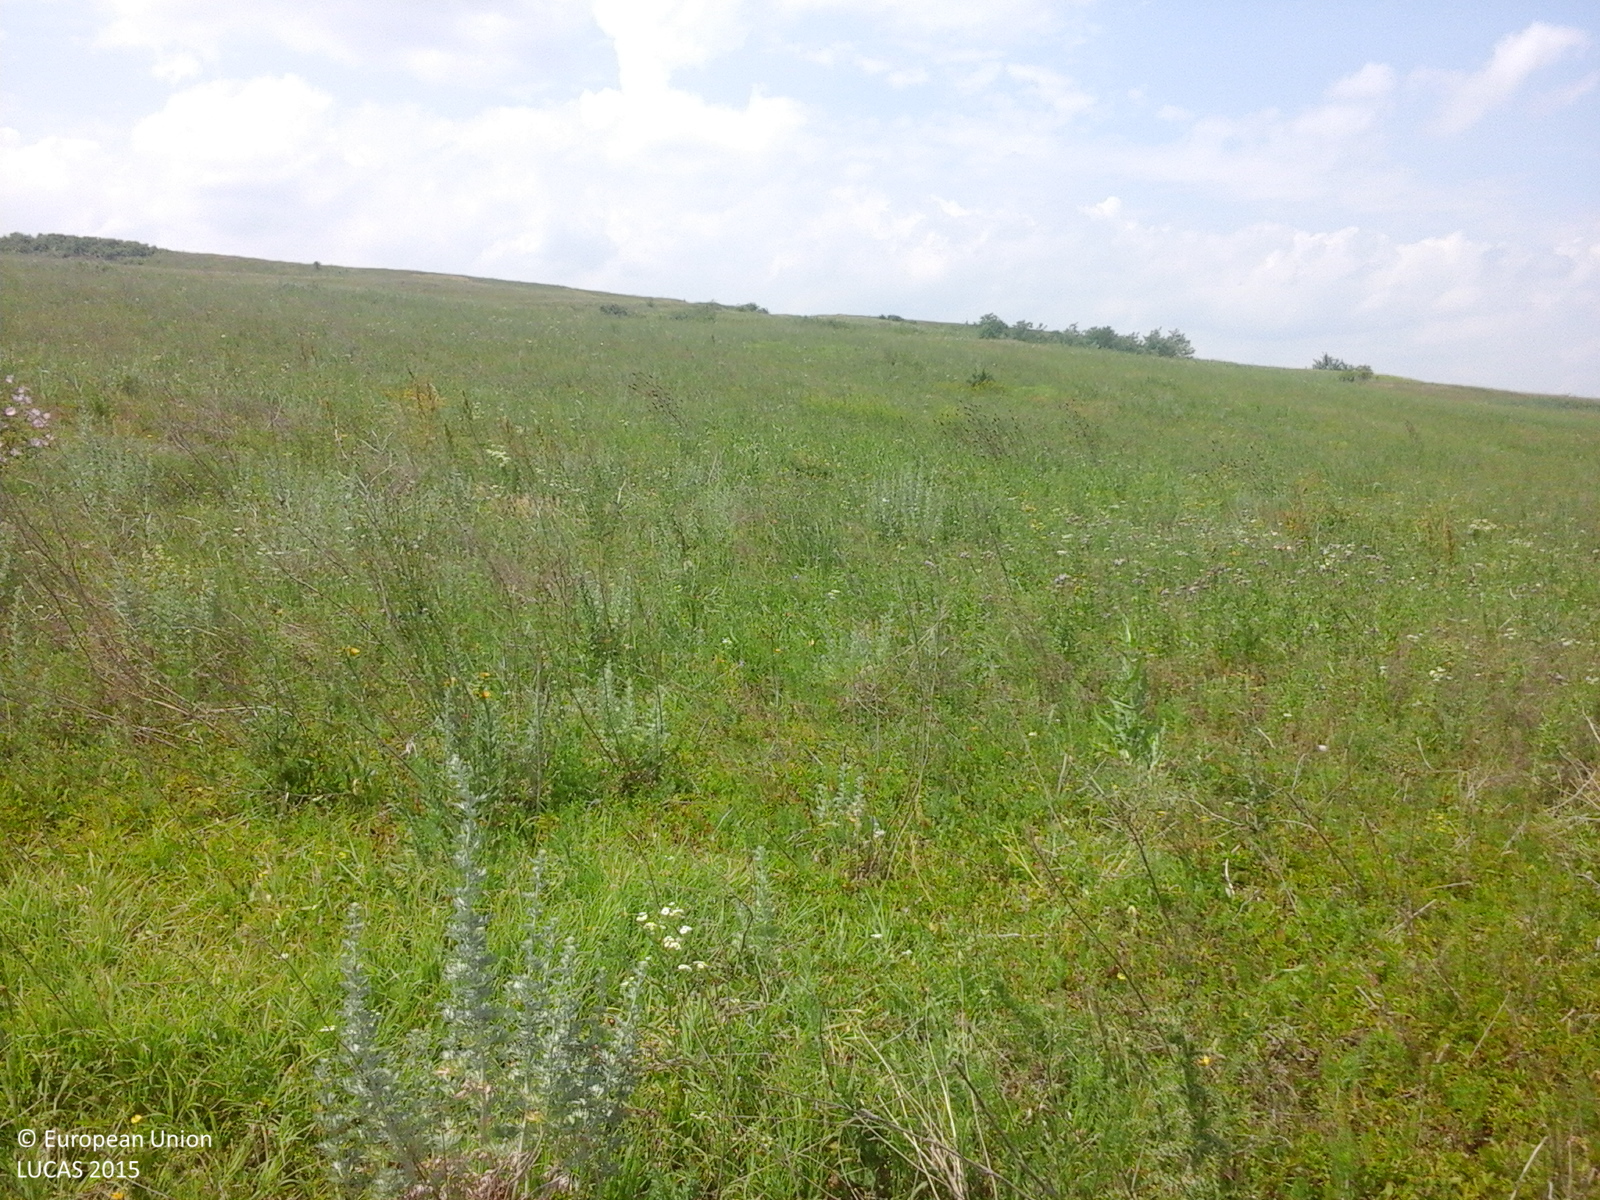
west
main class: Grassland
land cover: Spontaneously vegetated surfaces
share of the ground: > 75 %
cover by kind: herbaceous plants 100 %
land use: Agriculture (excluding fallow land and kitchen gardens)
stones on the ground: 10 - 25 %
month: June
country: RO
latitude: 47.4227
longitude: 27.0039
